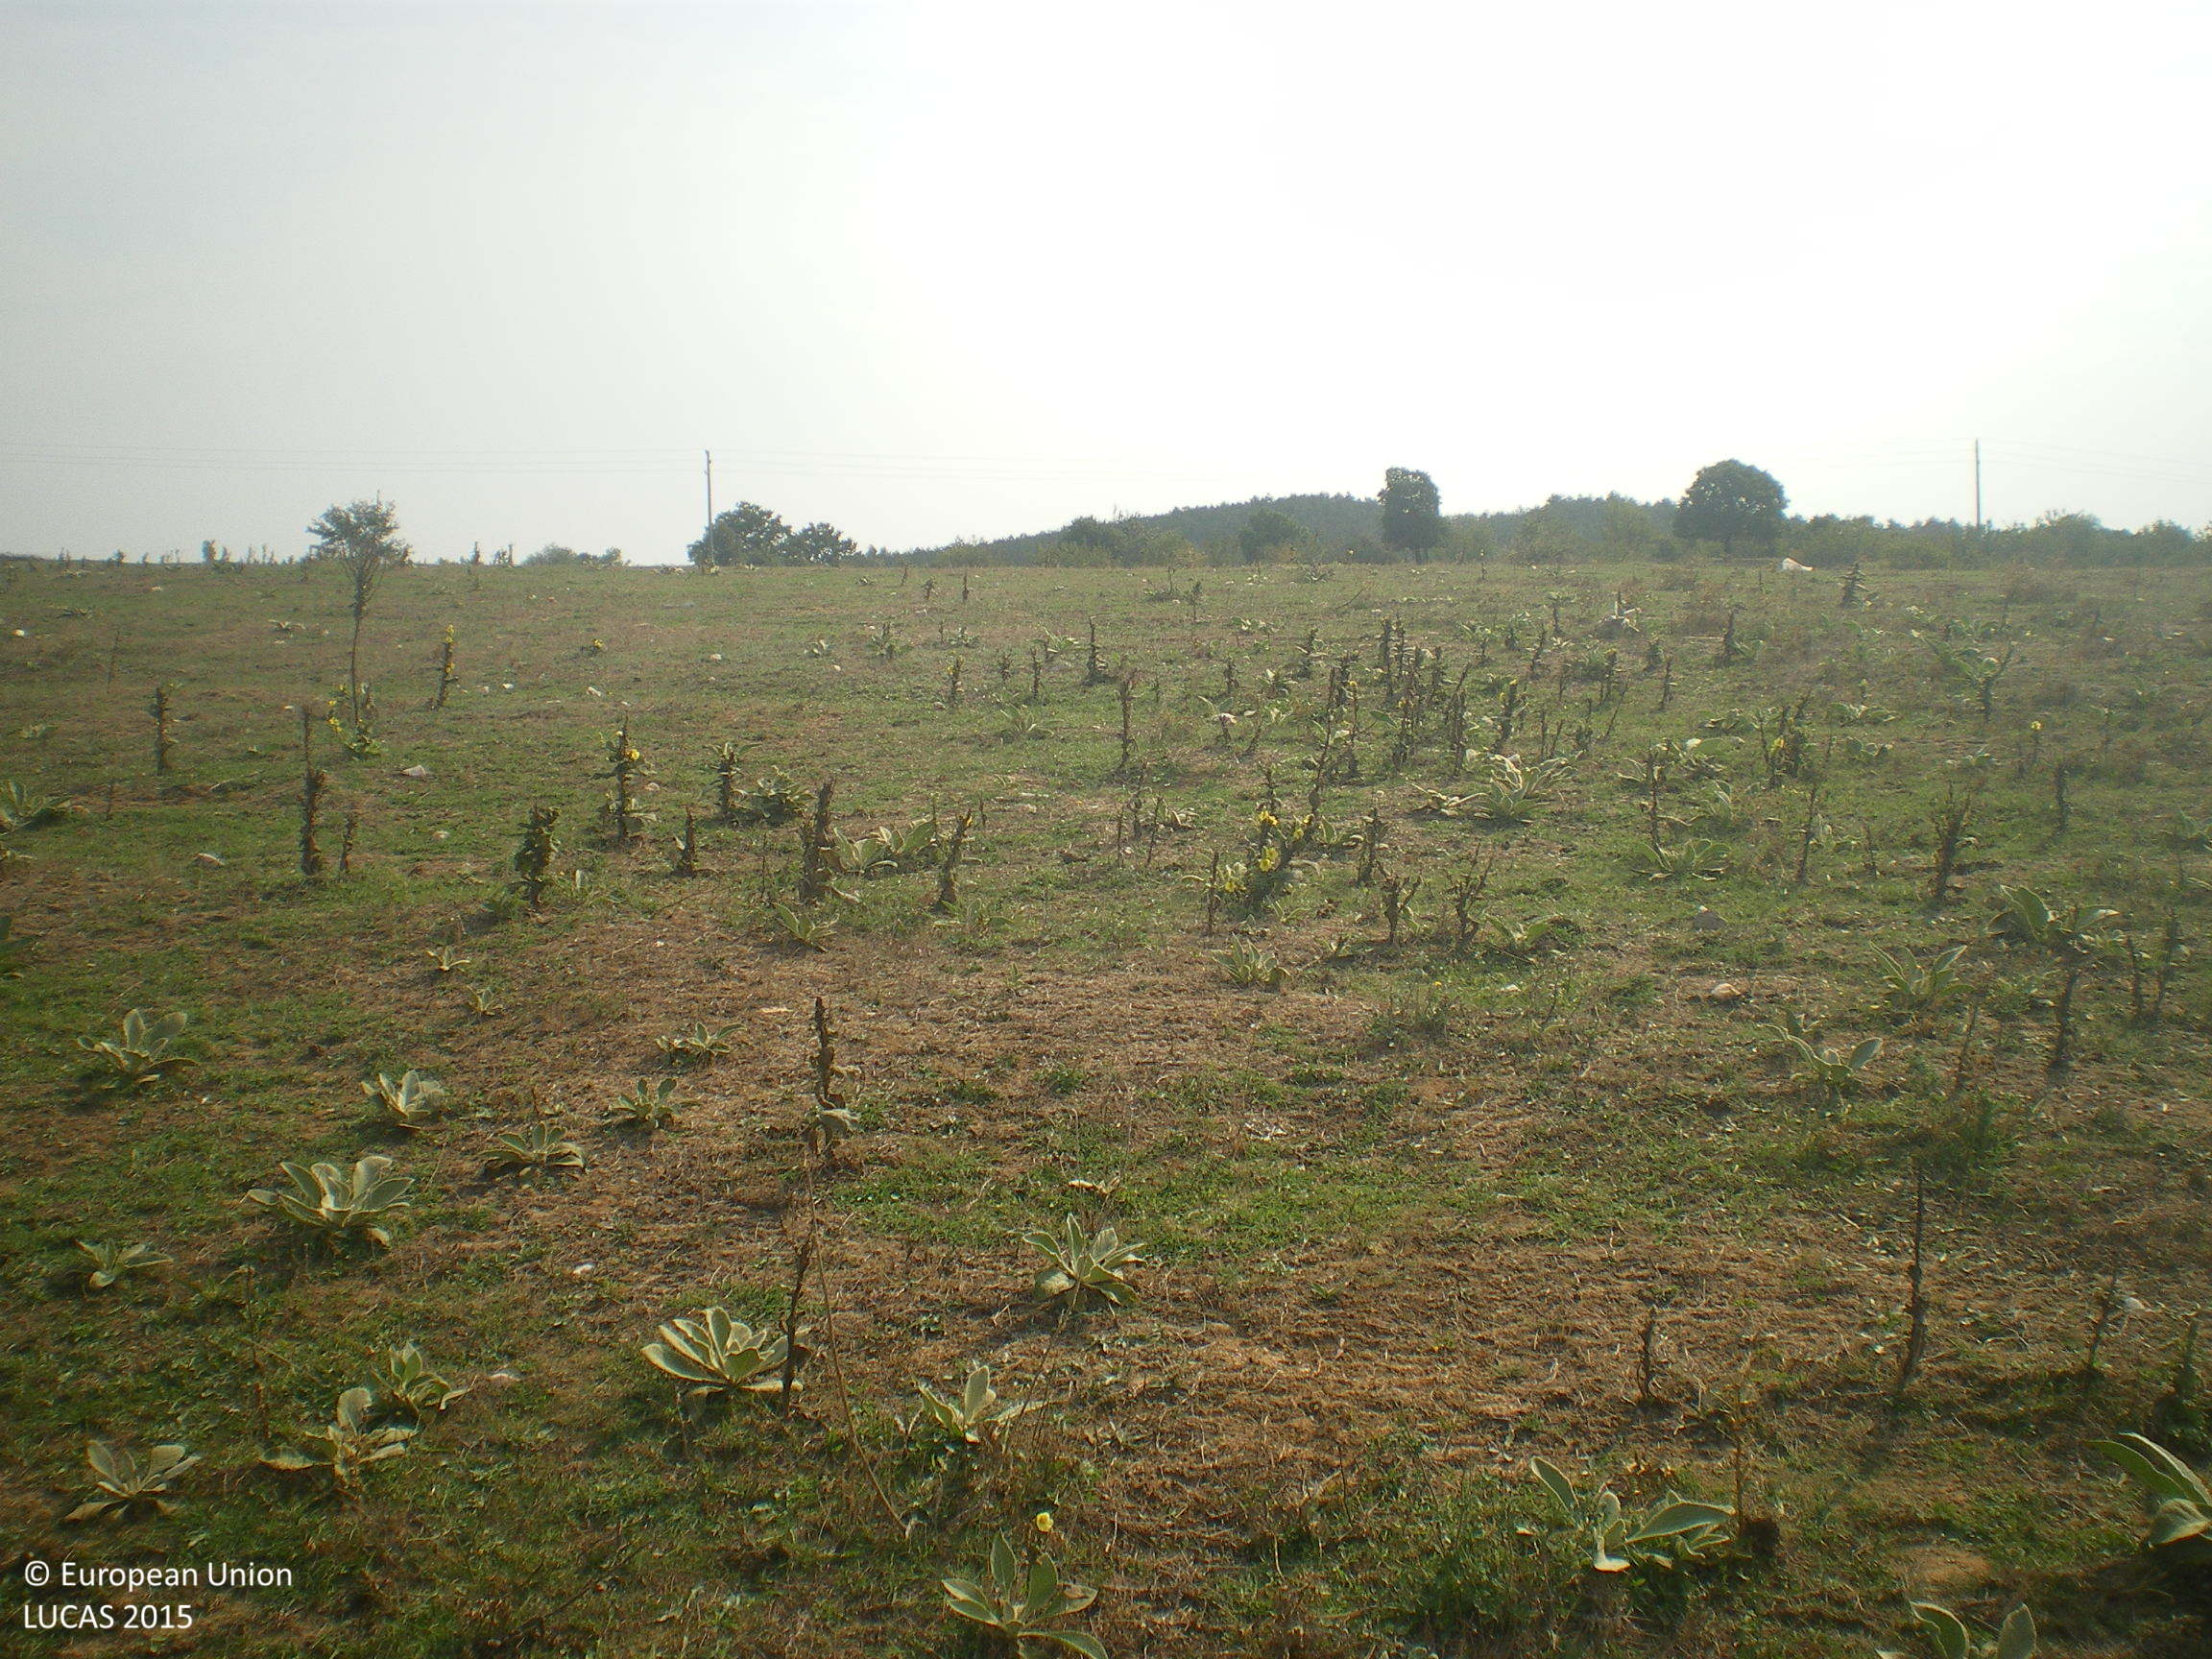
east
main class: Grassland
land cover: Grassland without tree/shrub cover
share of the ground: > 75 %
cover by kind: herbaceous plants 100 %
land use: Agriculture (excluding fallow land and kitchen gardens)
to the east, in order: Grassland without tree/shrub cover; Grassland with sparse tree/shrub cover; Grassland without tree/shrub cover; Electric lines; Grassland with sparse tree/shrub cover; Shrubland without tree cover
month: September
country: BG
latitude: 41.9033
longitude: 25.8986
